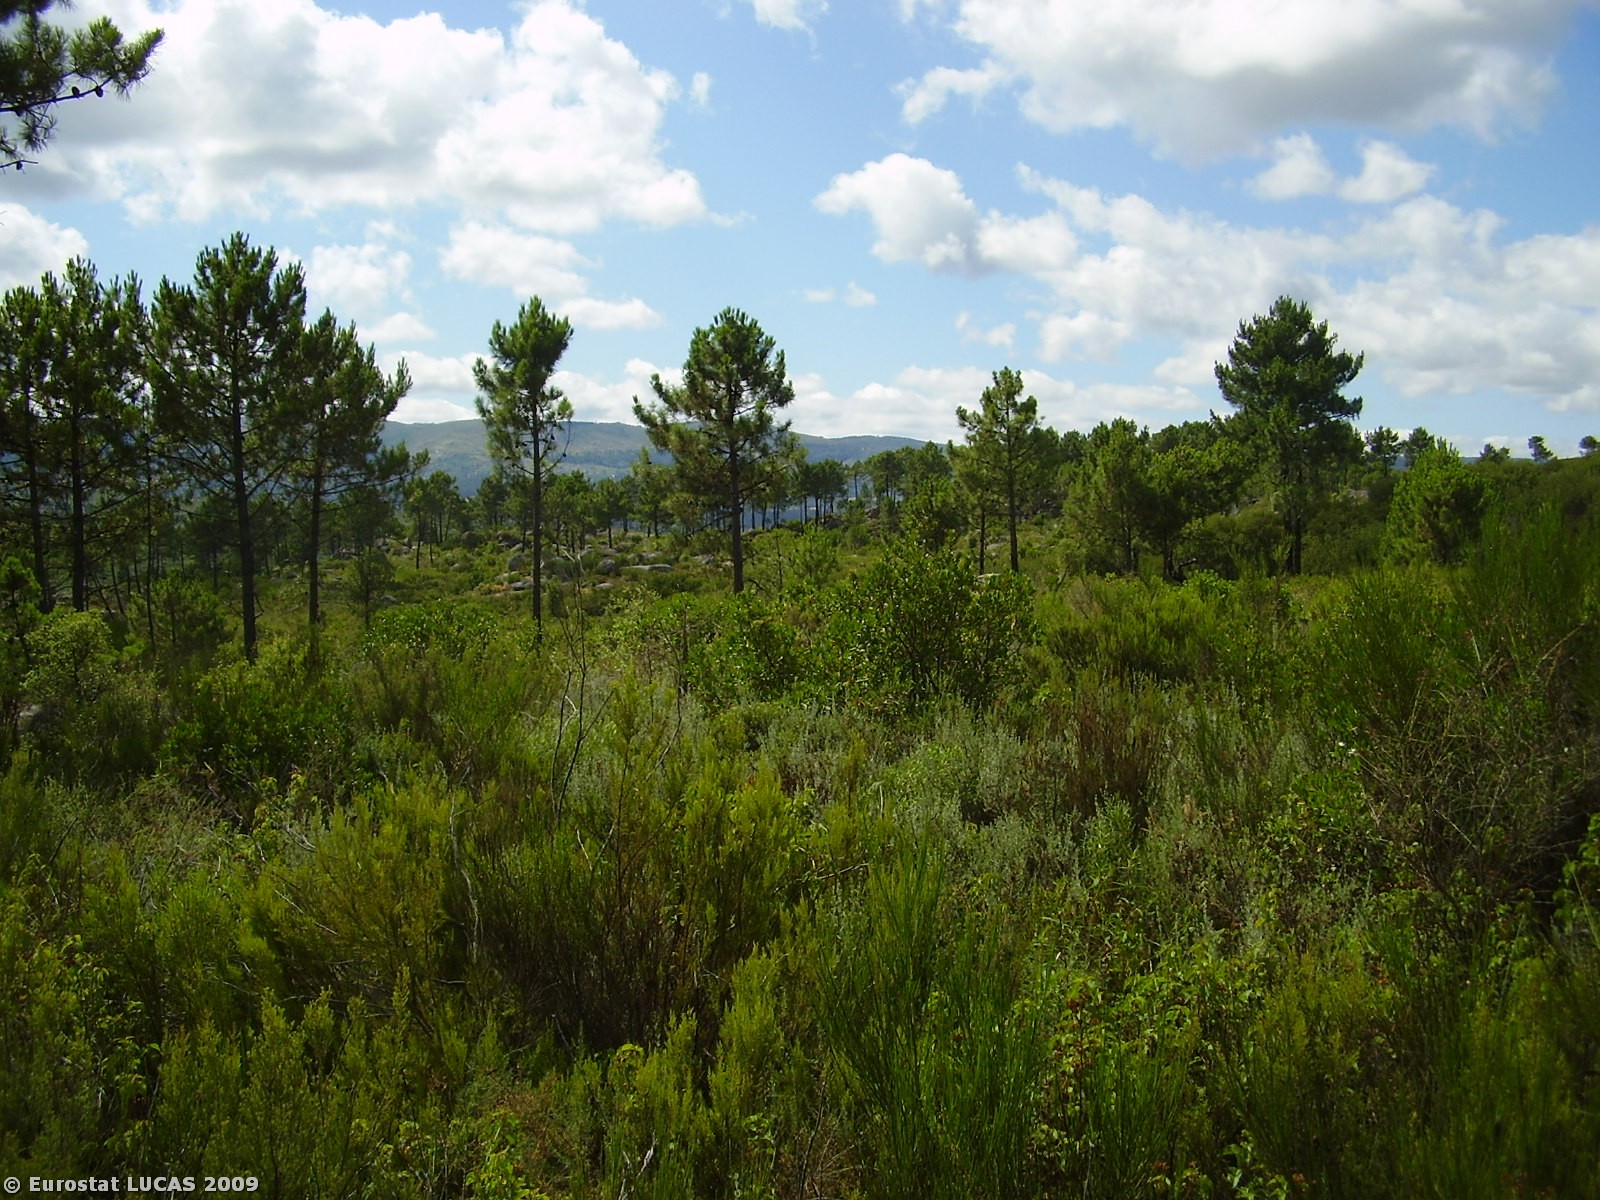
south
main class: Shrubland
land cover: Shrubland with sparse tree cover
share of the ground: > 75 %
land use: Unused
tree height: > 5 m
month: July
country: PT
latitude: 41.5986
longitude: -7.5877
